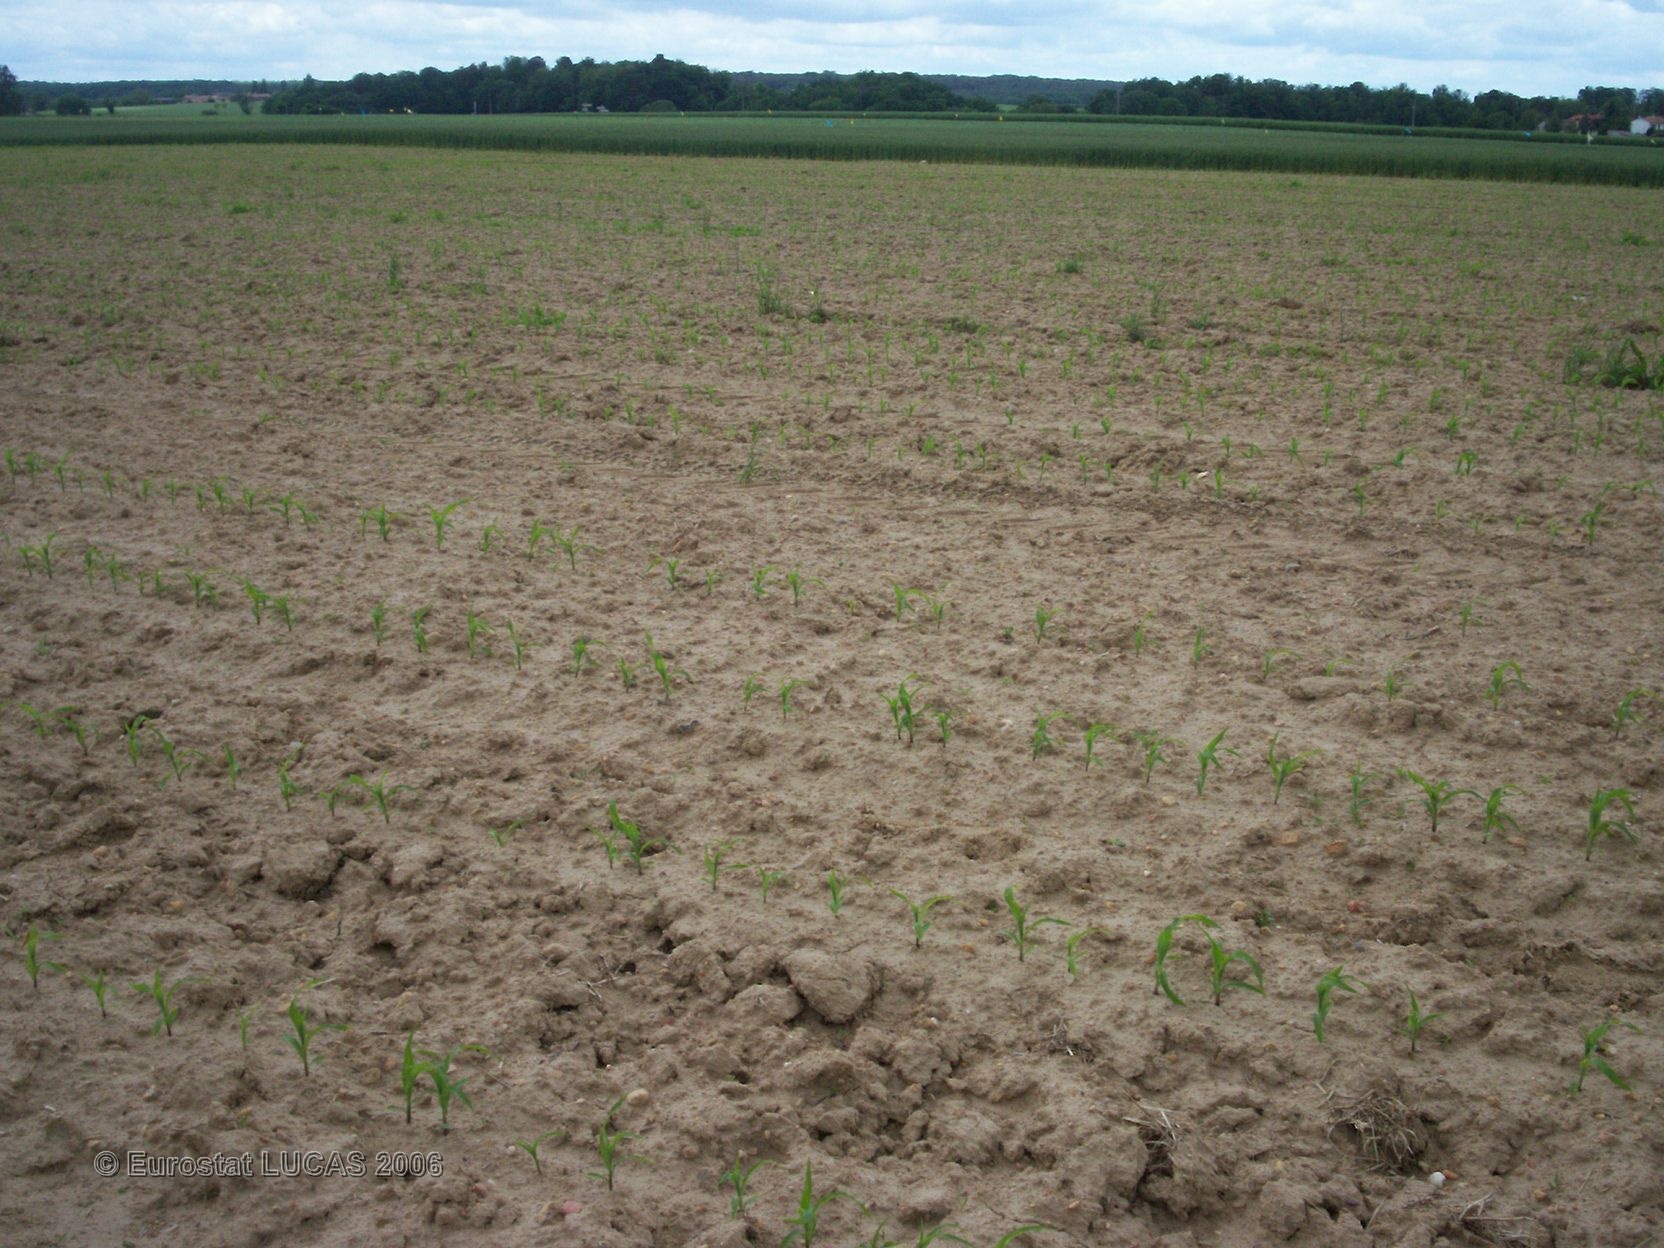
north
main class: Cropland
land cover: Maize
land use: Agriculture (excluding fallow land and kitchen gardens)
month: May
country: FR
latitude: 46.6401
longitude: 0.5635
